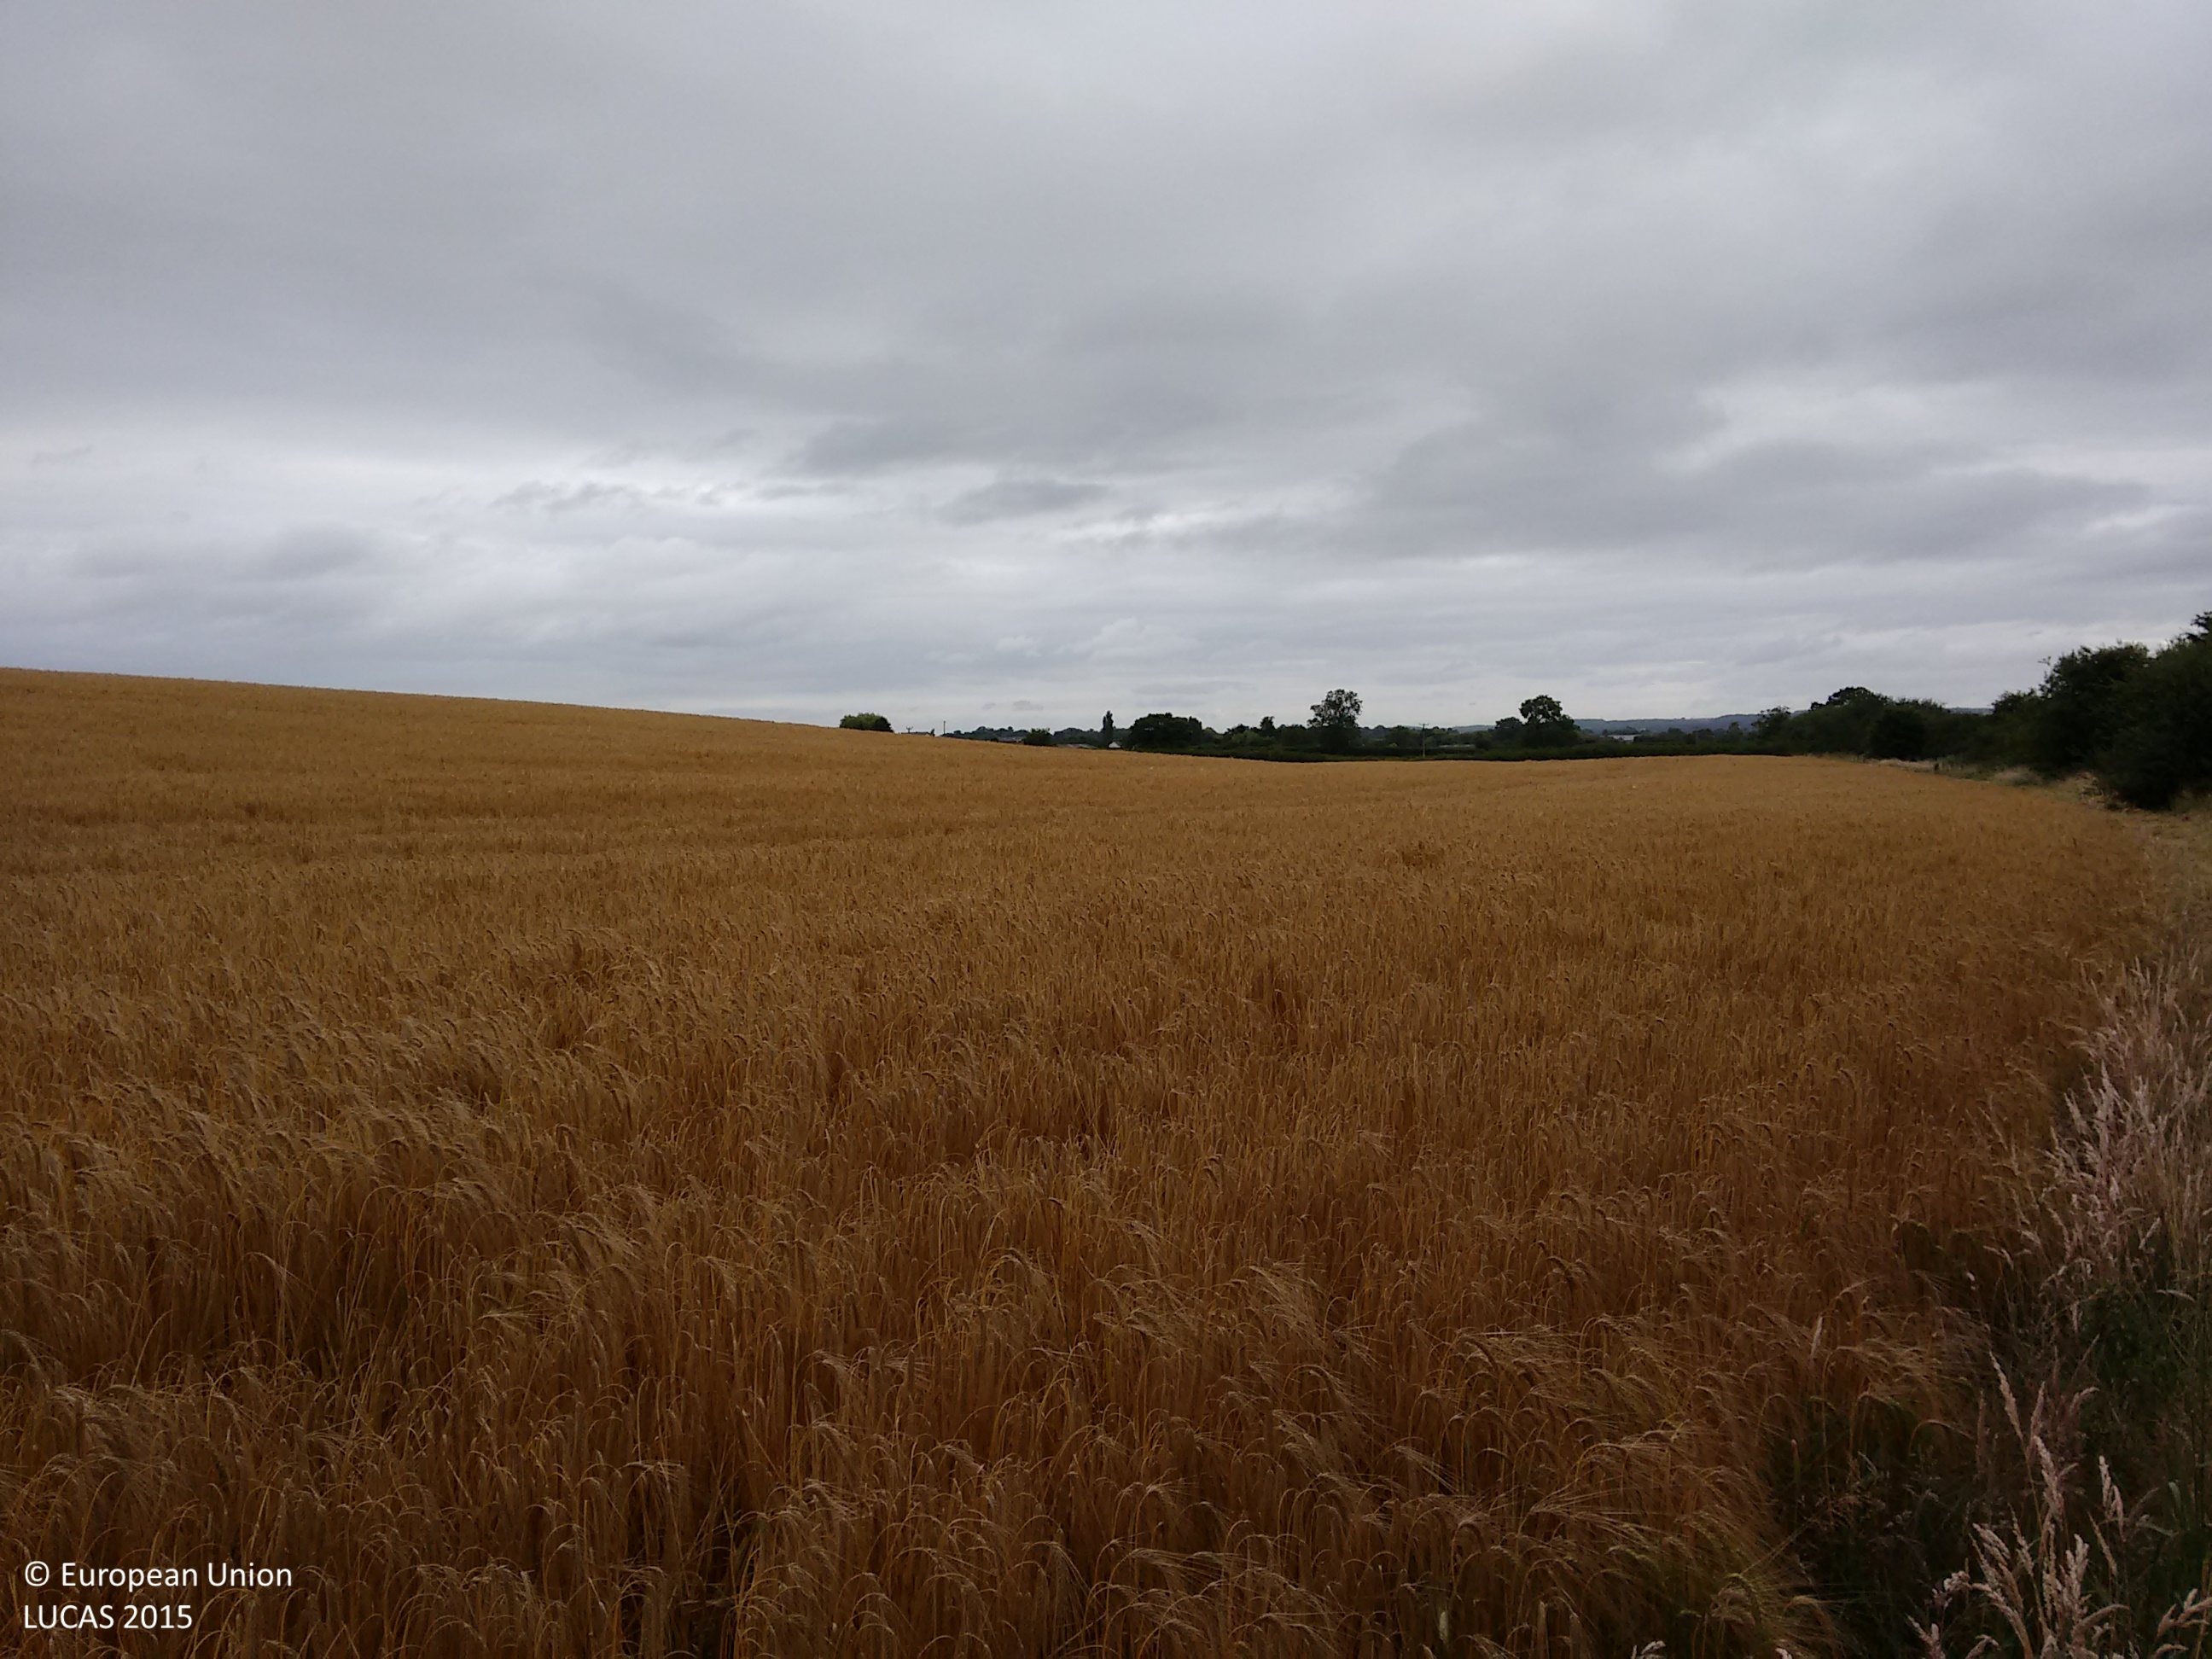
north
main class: Cropland
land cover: Barley
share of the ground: > 75 %
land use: Agriculture (excluding fallow land and kitchen gardens)
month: July
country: GB
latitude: 53.1918
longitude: -2.8080
